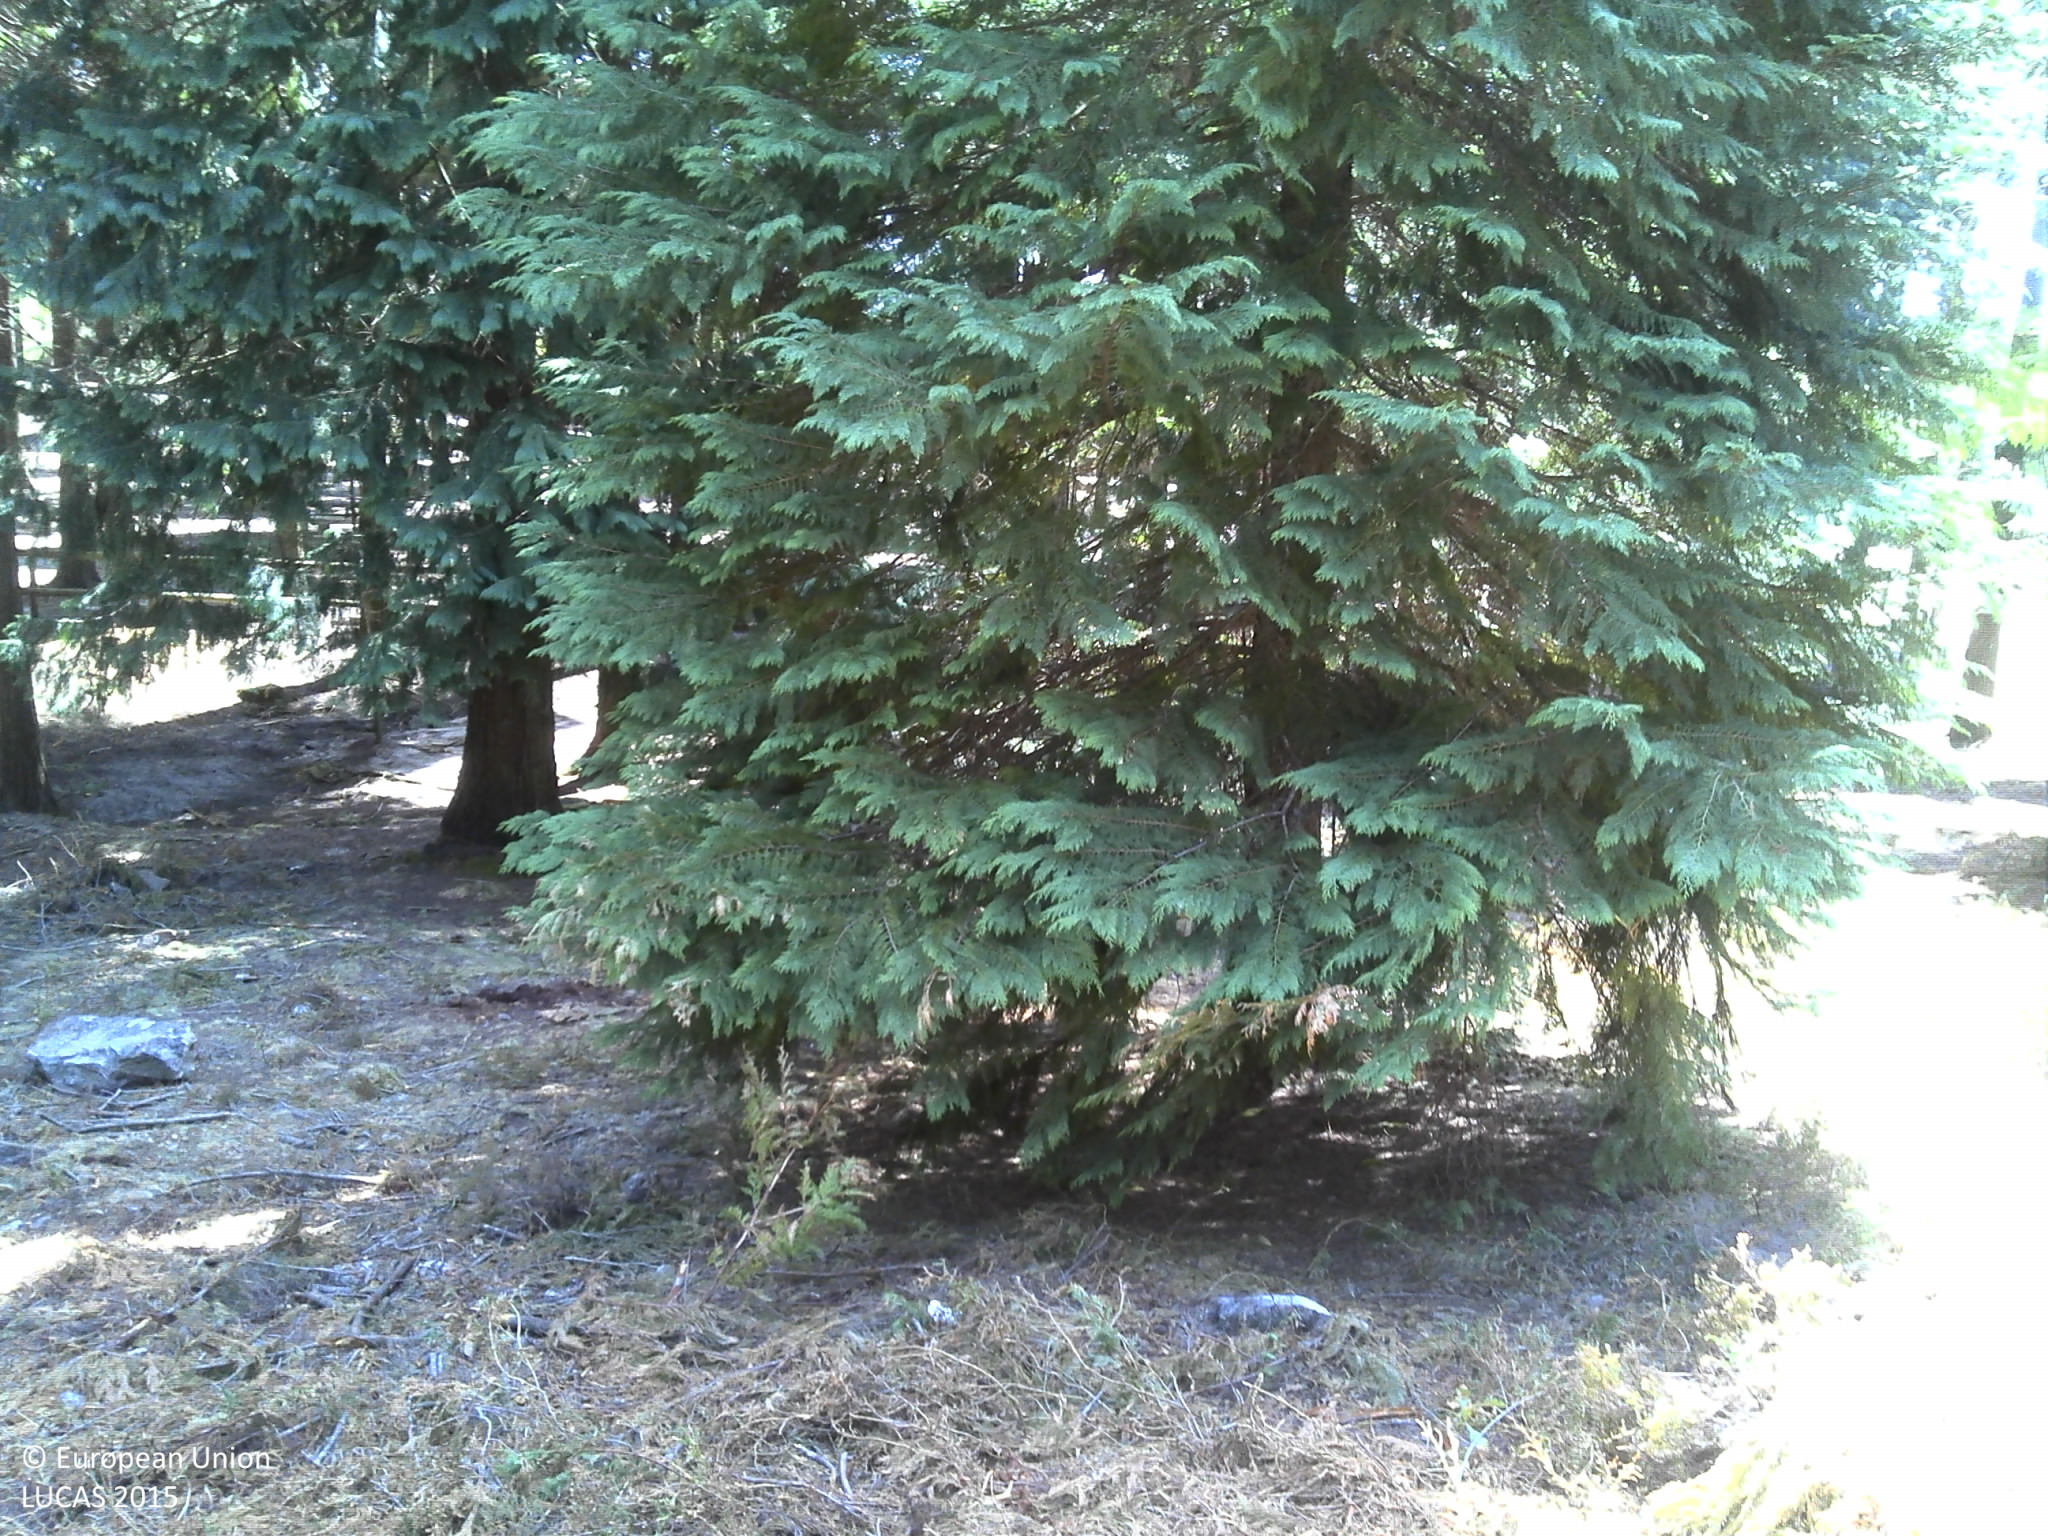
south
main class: Woodland
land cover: Other coniferous woodland
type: coniferous forest of the mediterranean region
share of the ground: 50 - 75 %
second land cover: Grassland without tree/shrub cover
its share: 25 - 50 %
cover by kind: coniferous forest trees 70 %, herbaceous plants 20 %, shrubs 5 %, unconsolidated bare surface 5 %
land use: Forestry
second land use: Agriculture (excluding fallow land and kitchen gardens)
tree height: > 5 m
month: July
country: PT
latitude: 41.6581
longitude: -8.0744
